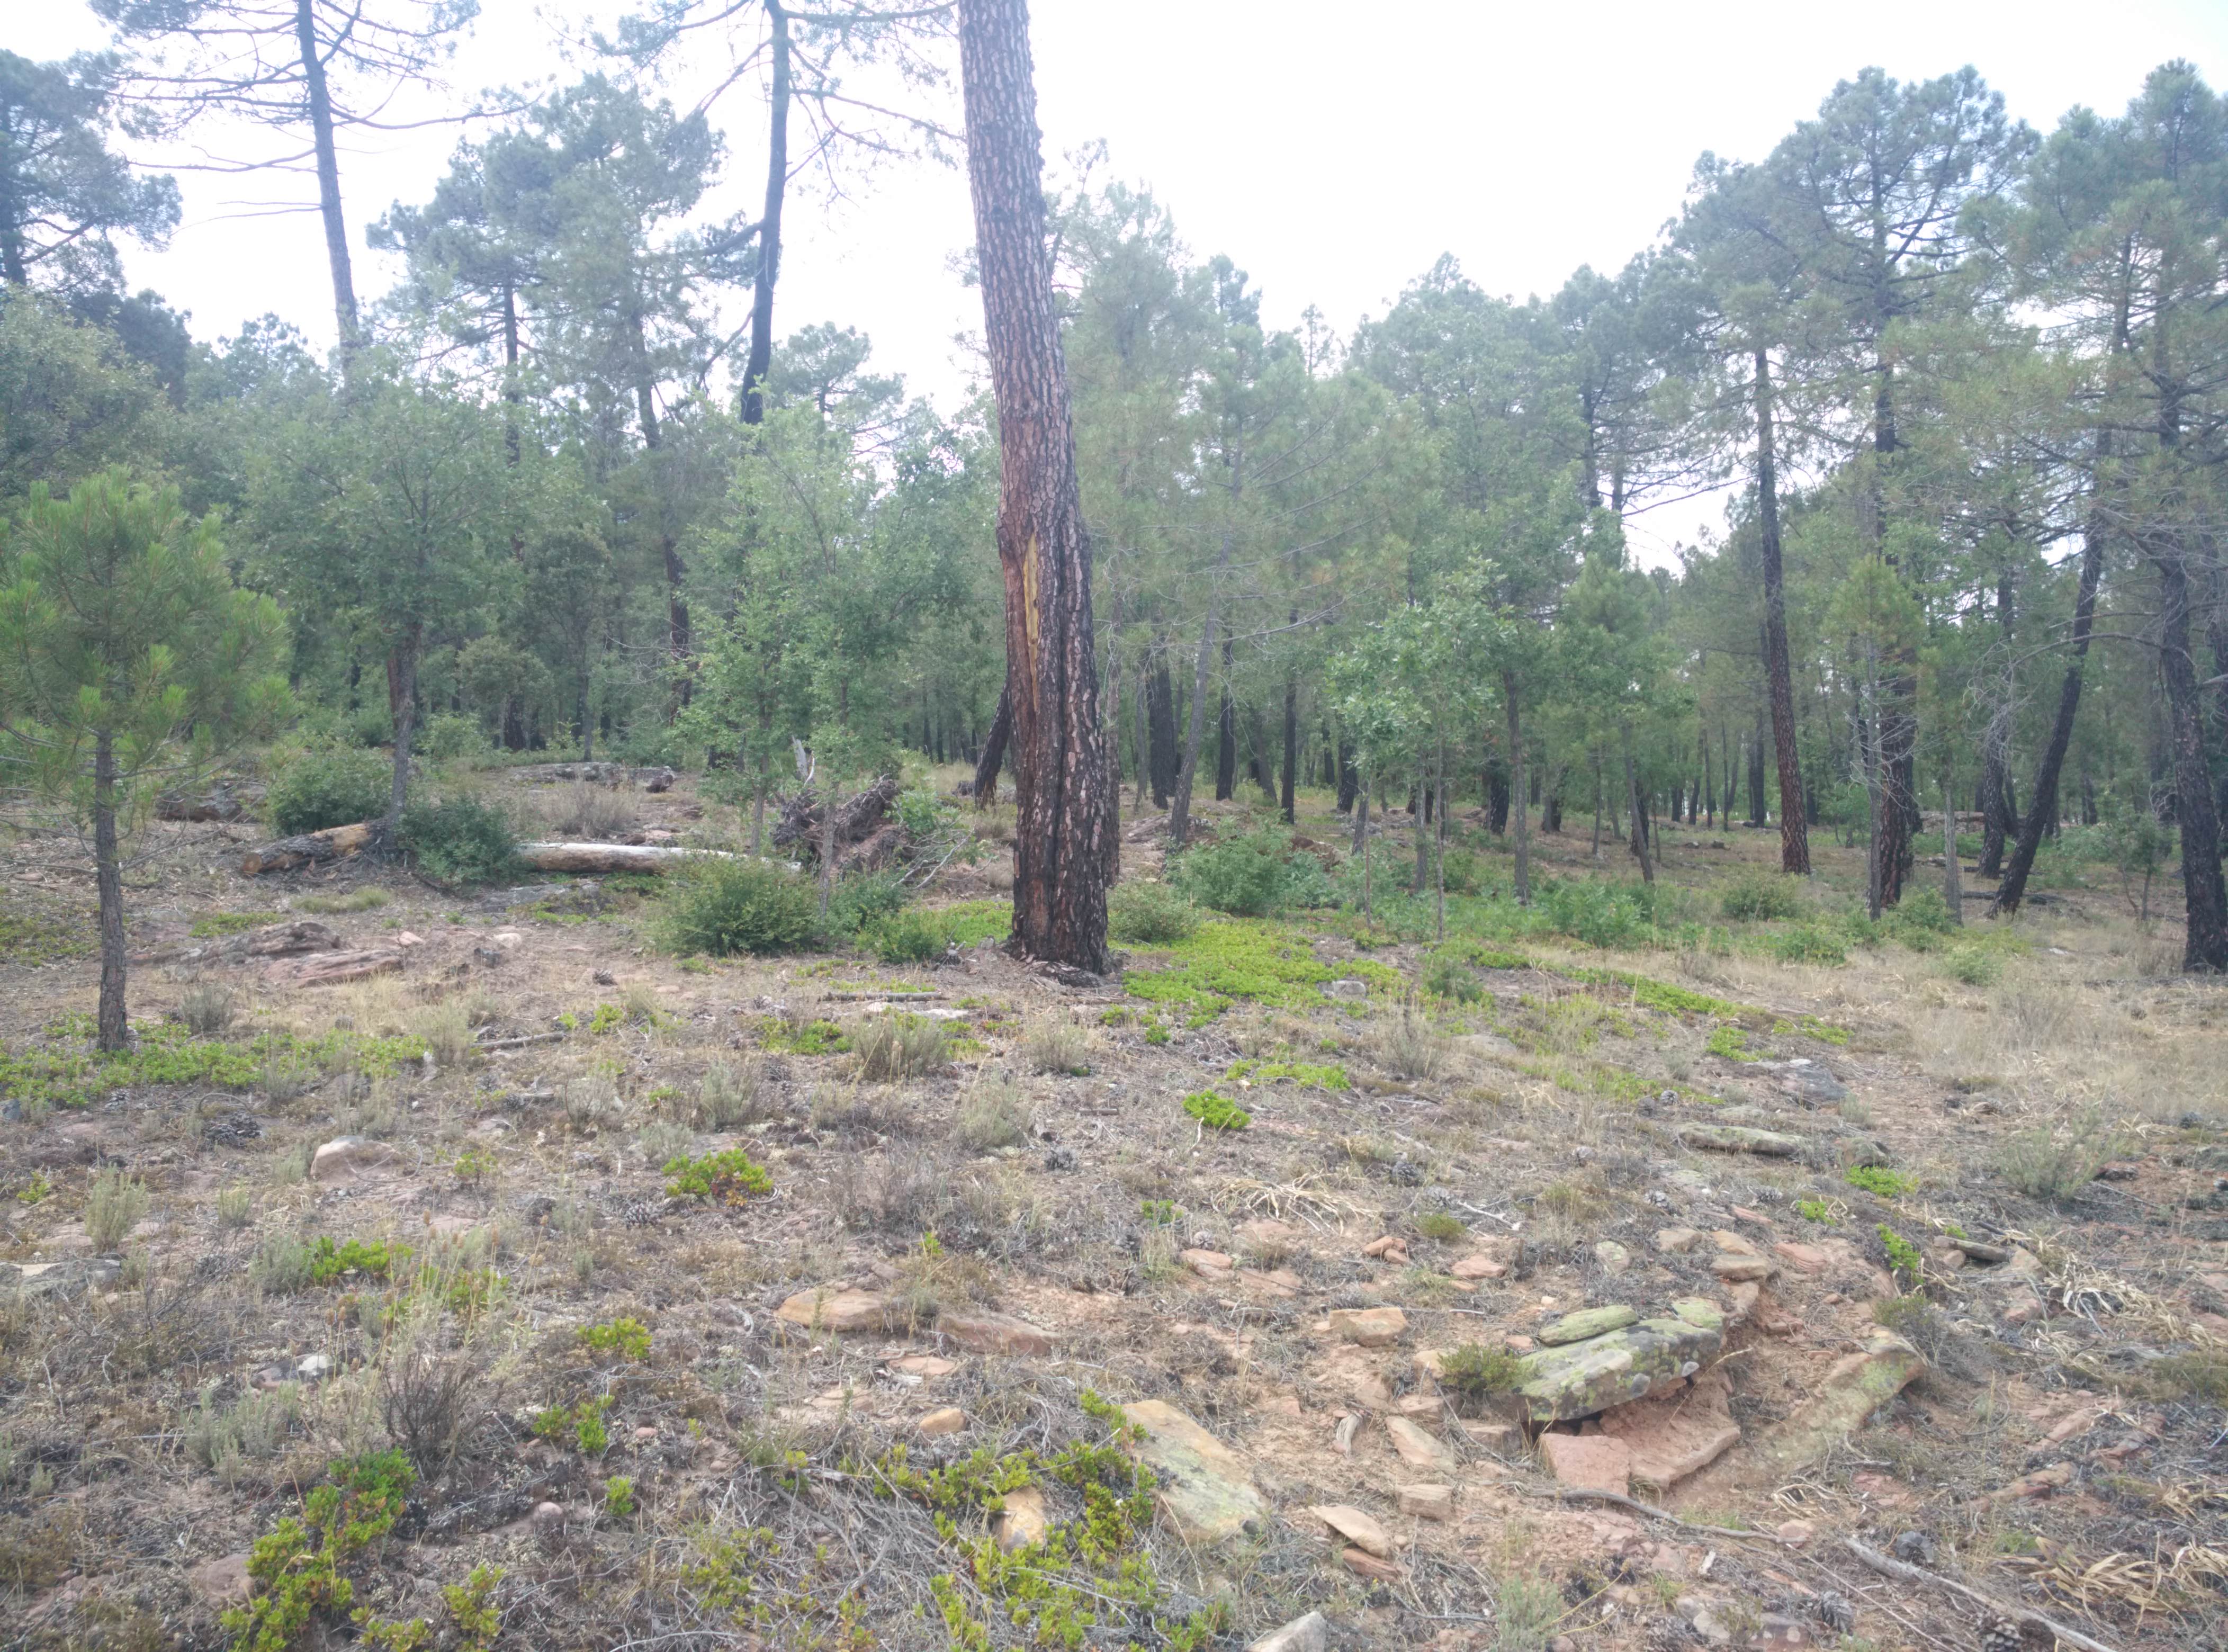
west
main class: Woodland
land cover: Pine dominated coniferous woodland
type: coniferous forest of the mediterranean region
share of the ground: > 75 %
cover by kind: coniferous forest trees 95 %, unconsolidated bare surface 5 %
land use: Semi-natural and natural areas not in use
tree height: > 5 m
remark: Burnt area
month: July
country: ES
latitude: 40.8384
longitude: -2.0373
